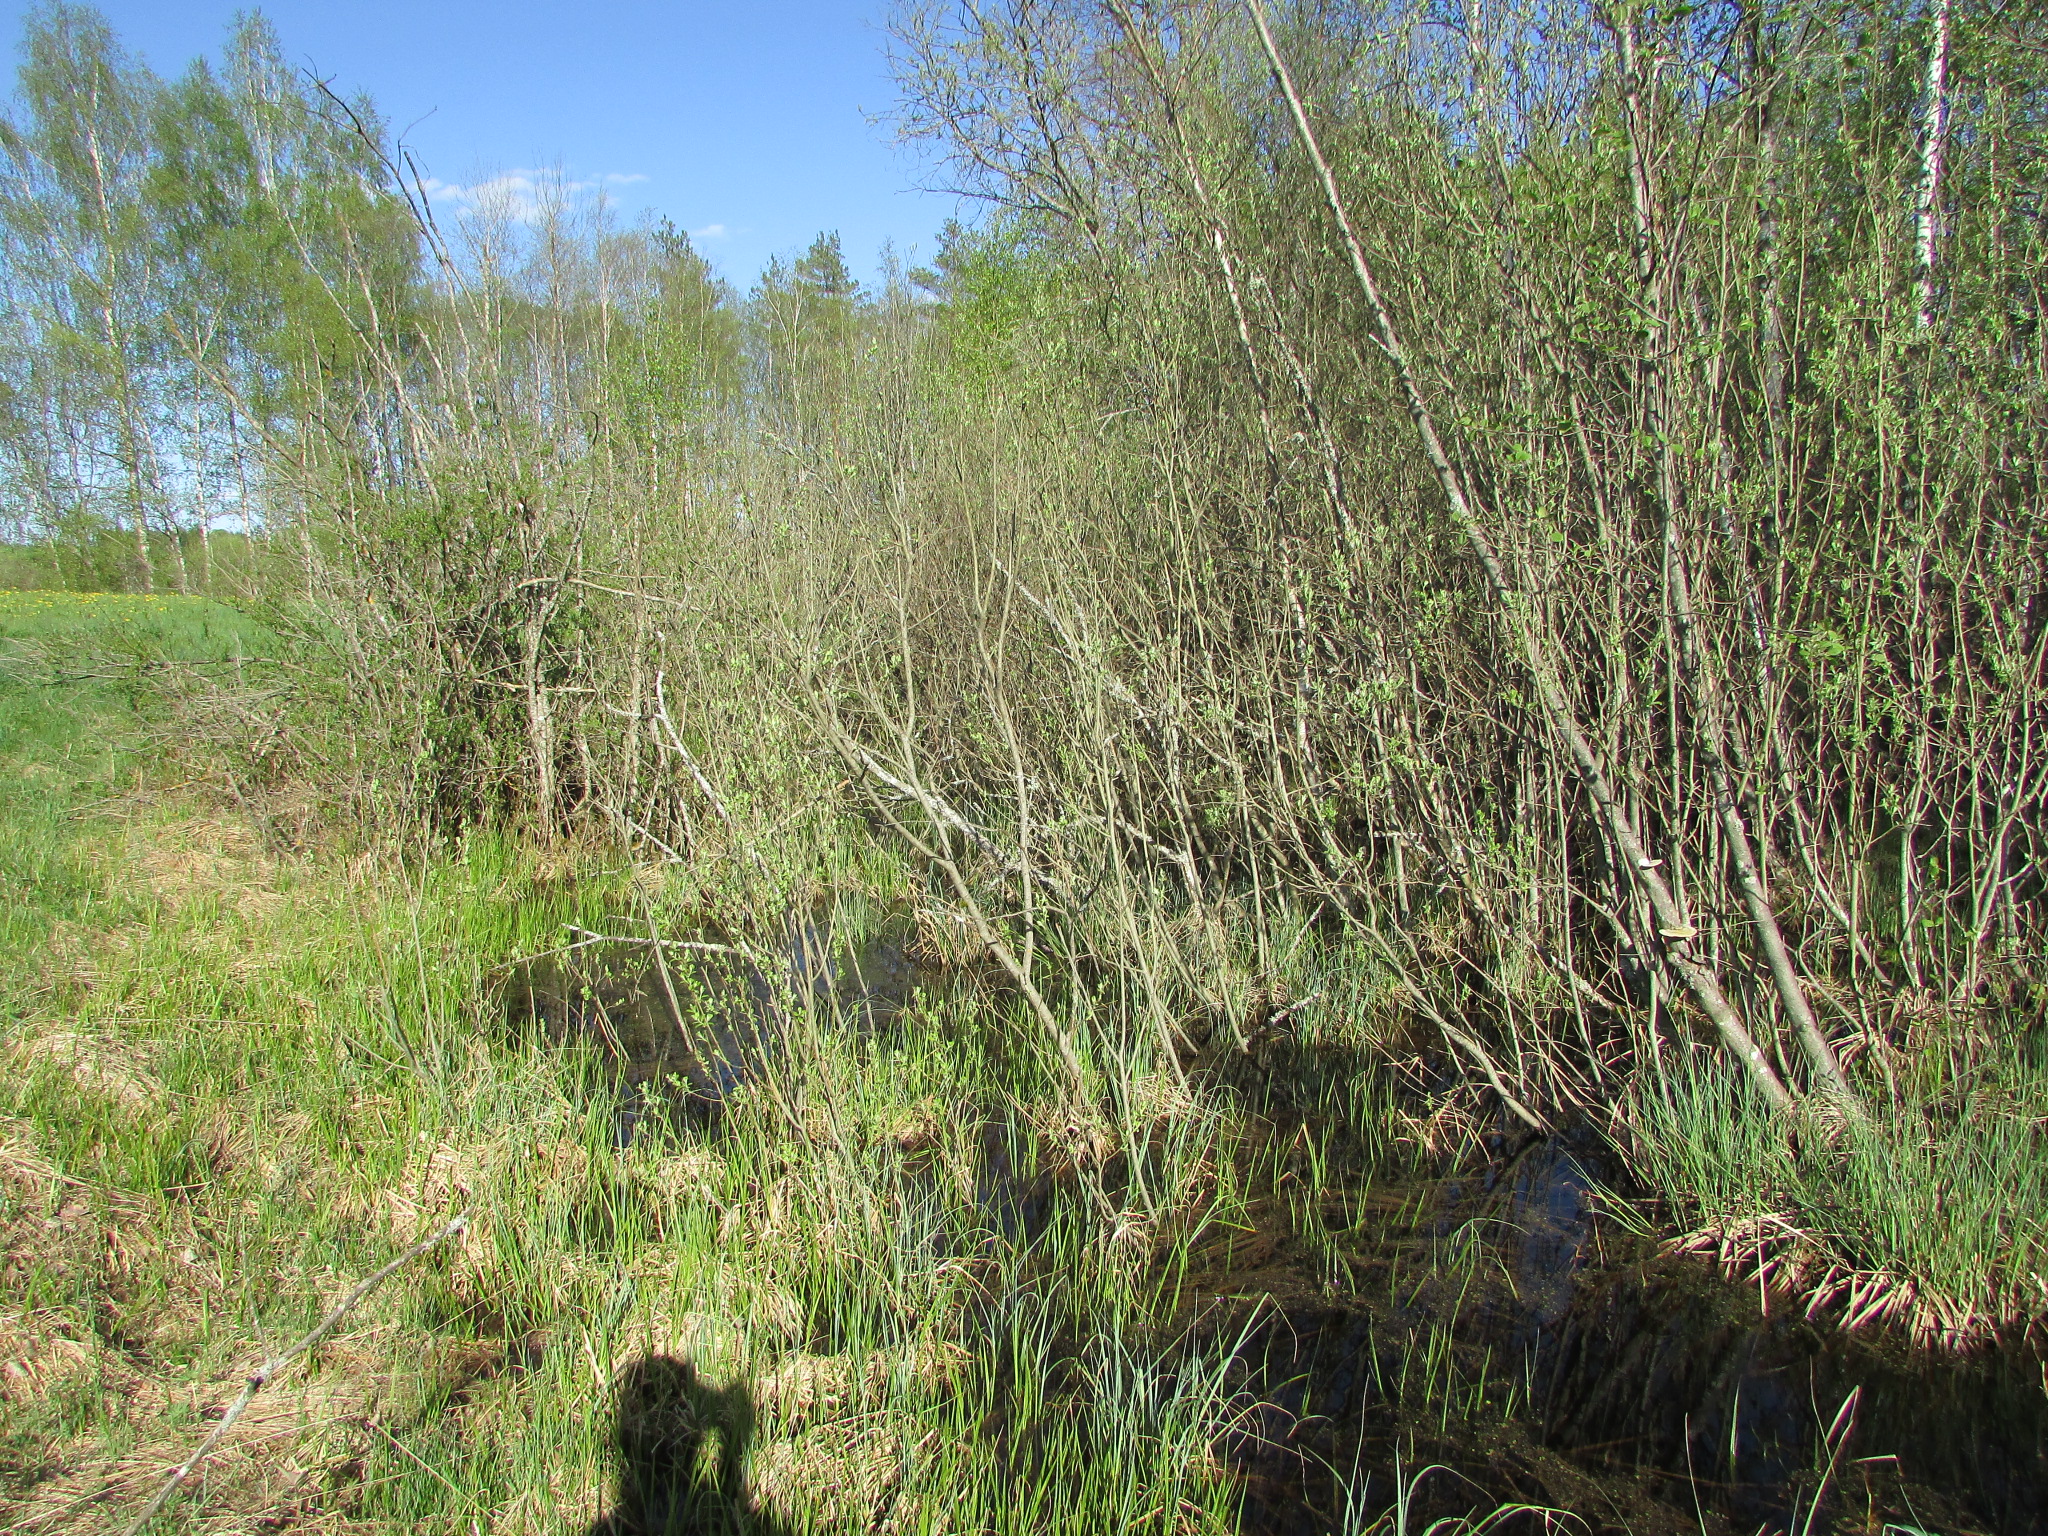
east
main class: Woodland
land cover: Broadleaved woodland
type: non-riverine alder, birch or aspen forest
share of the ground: > 75 %
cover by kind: broadleaved forest trees 100 %
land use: Semi-natural and natural areas not in use
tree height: > 5 m
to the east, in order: Broadleaved woodland; Grassland without tree/shrub cover; Broadleaved woodland; Grassland without tree/shrub cover; Spontaneously vegetated surfaces; Grassland with sparse tree/shrub cover; Spontaneously vegetated surfaces
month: May
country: LV
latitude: 56.1270
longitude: 27.1418
